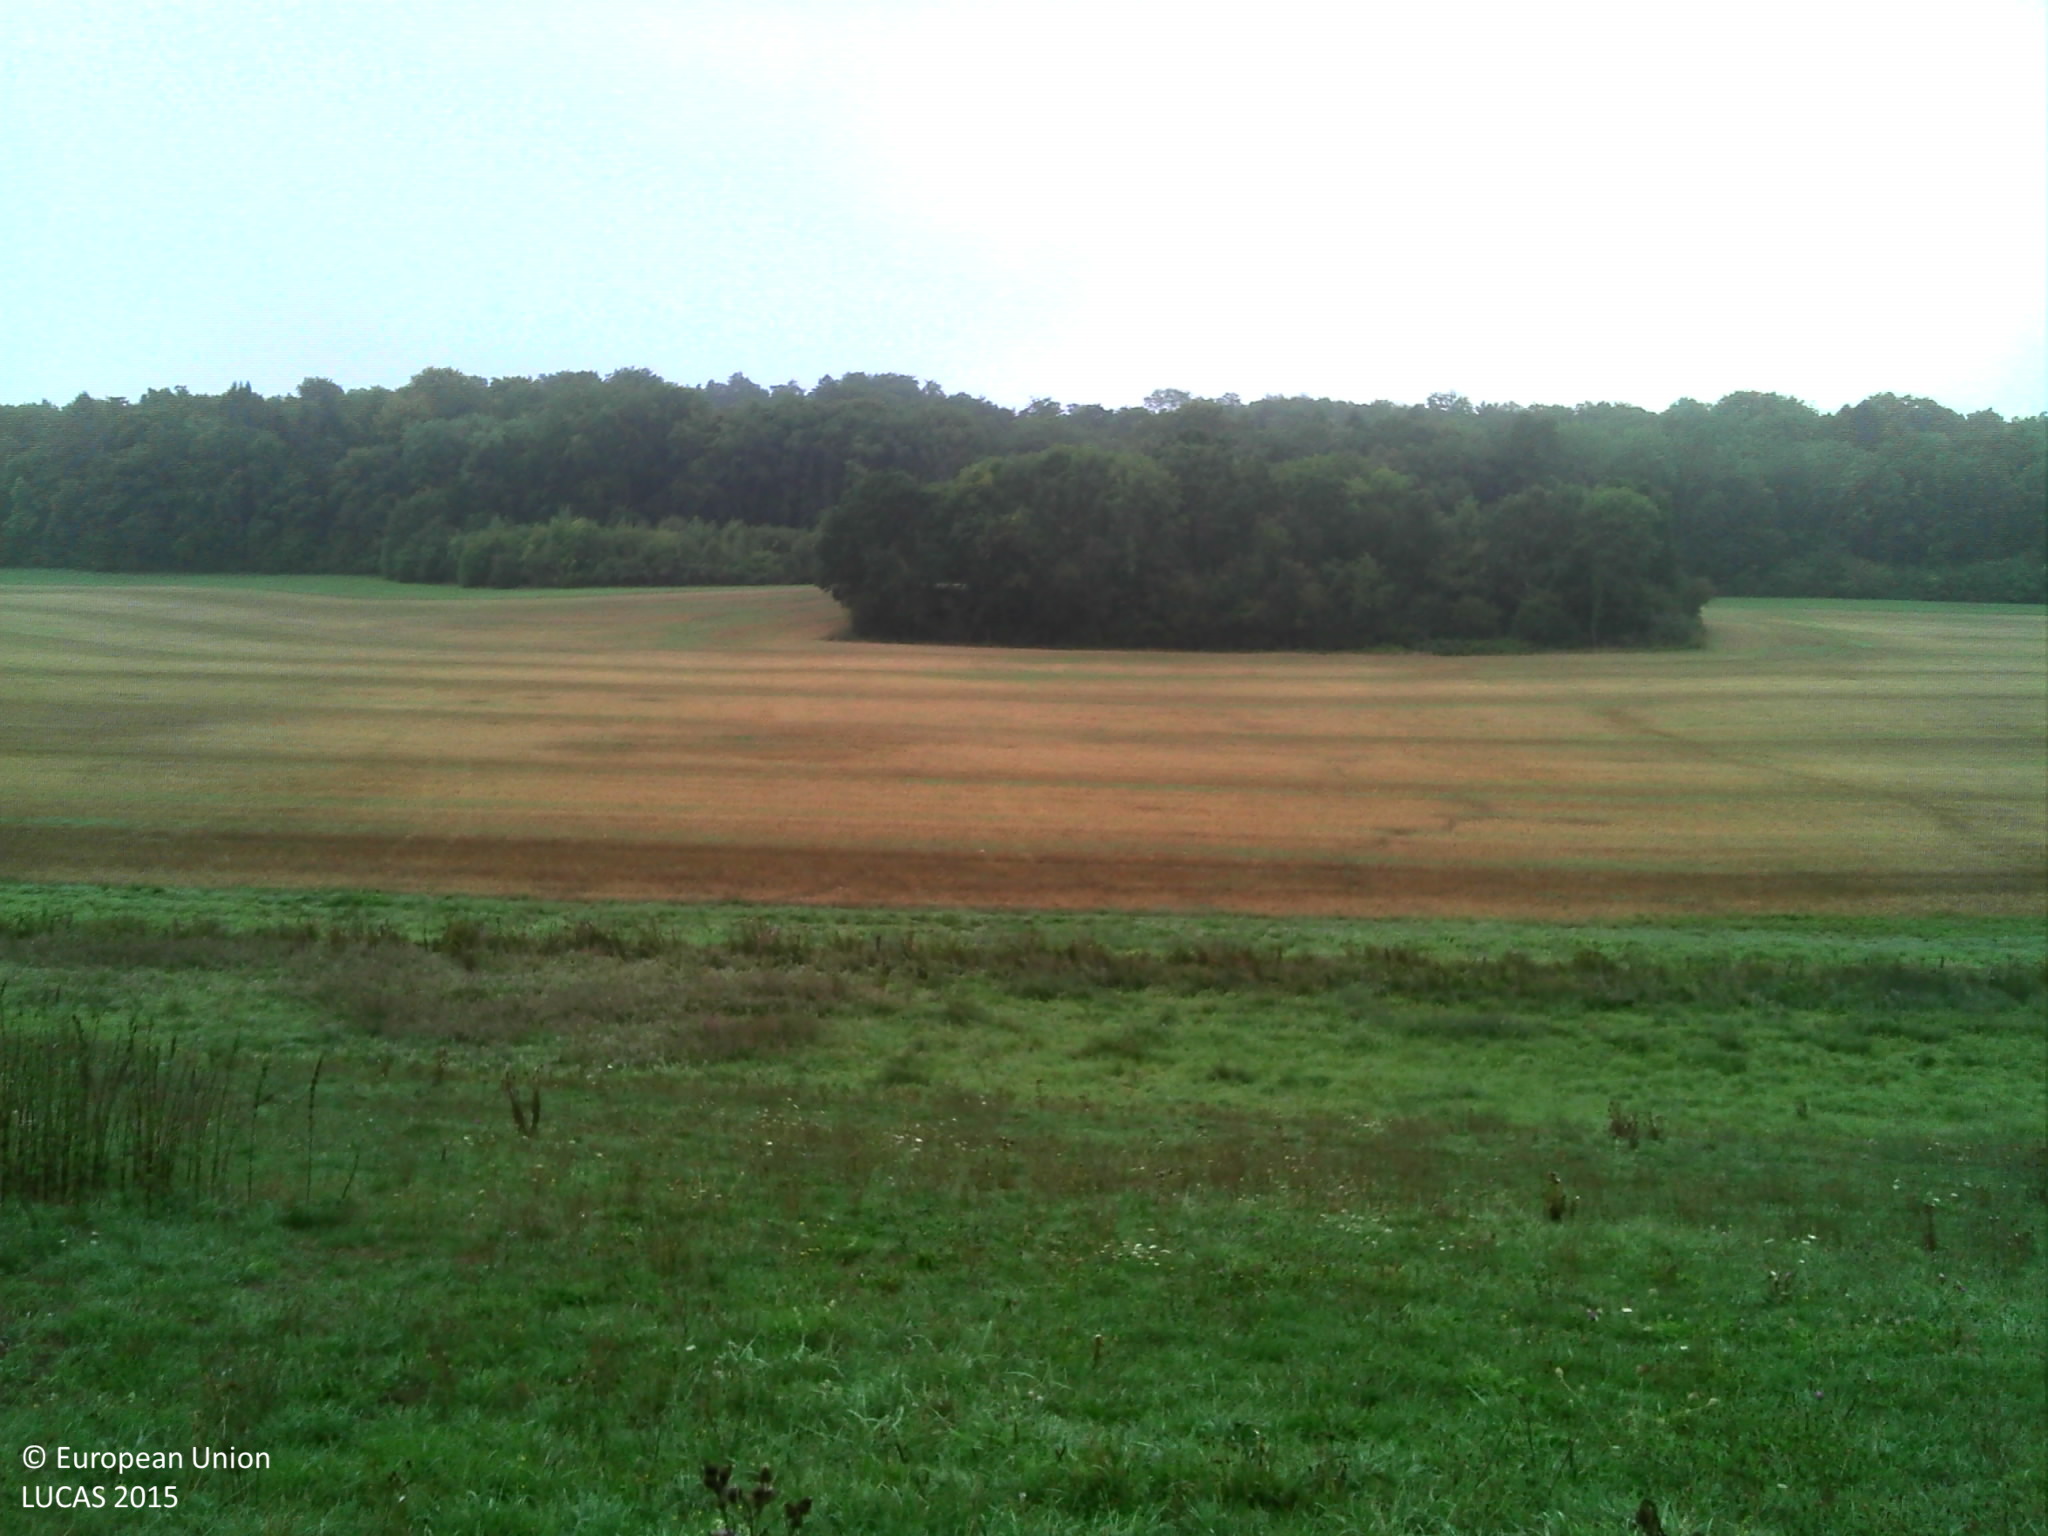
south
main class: Woodland
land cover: Broadleaved woodland
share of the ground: > 75 %
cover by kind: broadleaved forest trees 85 %, shrubs 10 %, herbaceous plants 5 %
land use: Agriculture (excluding fallow land and kitchen gardens)
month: September
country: FR
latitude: 47.6135
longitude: 4.4244
